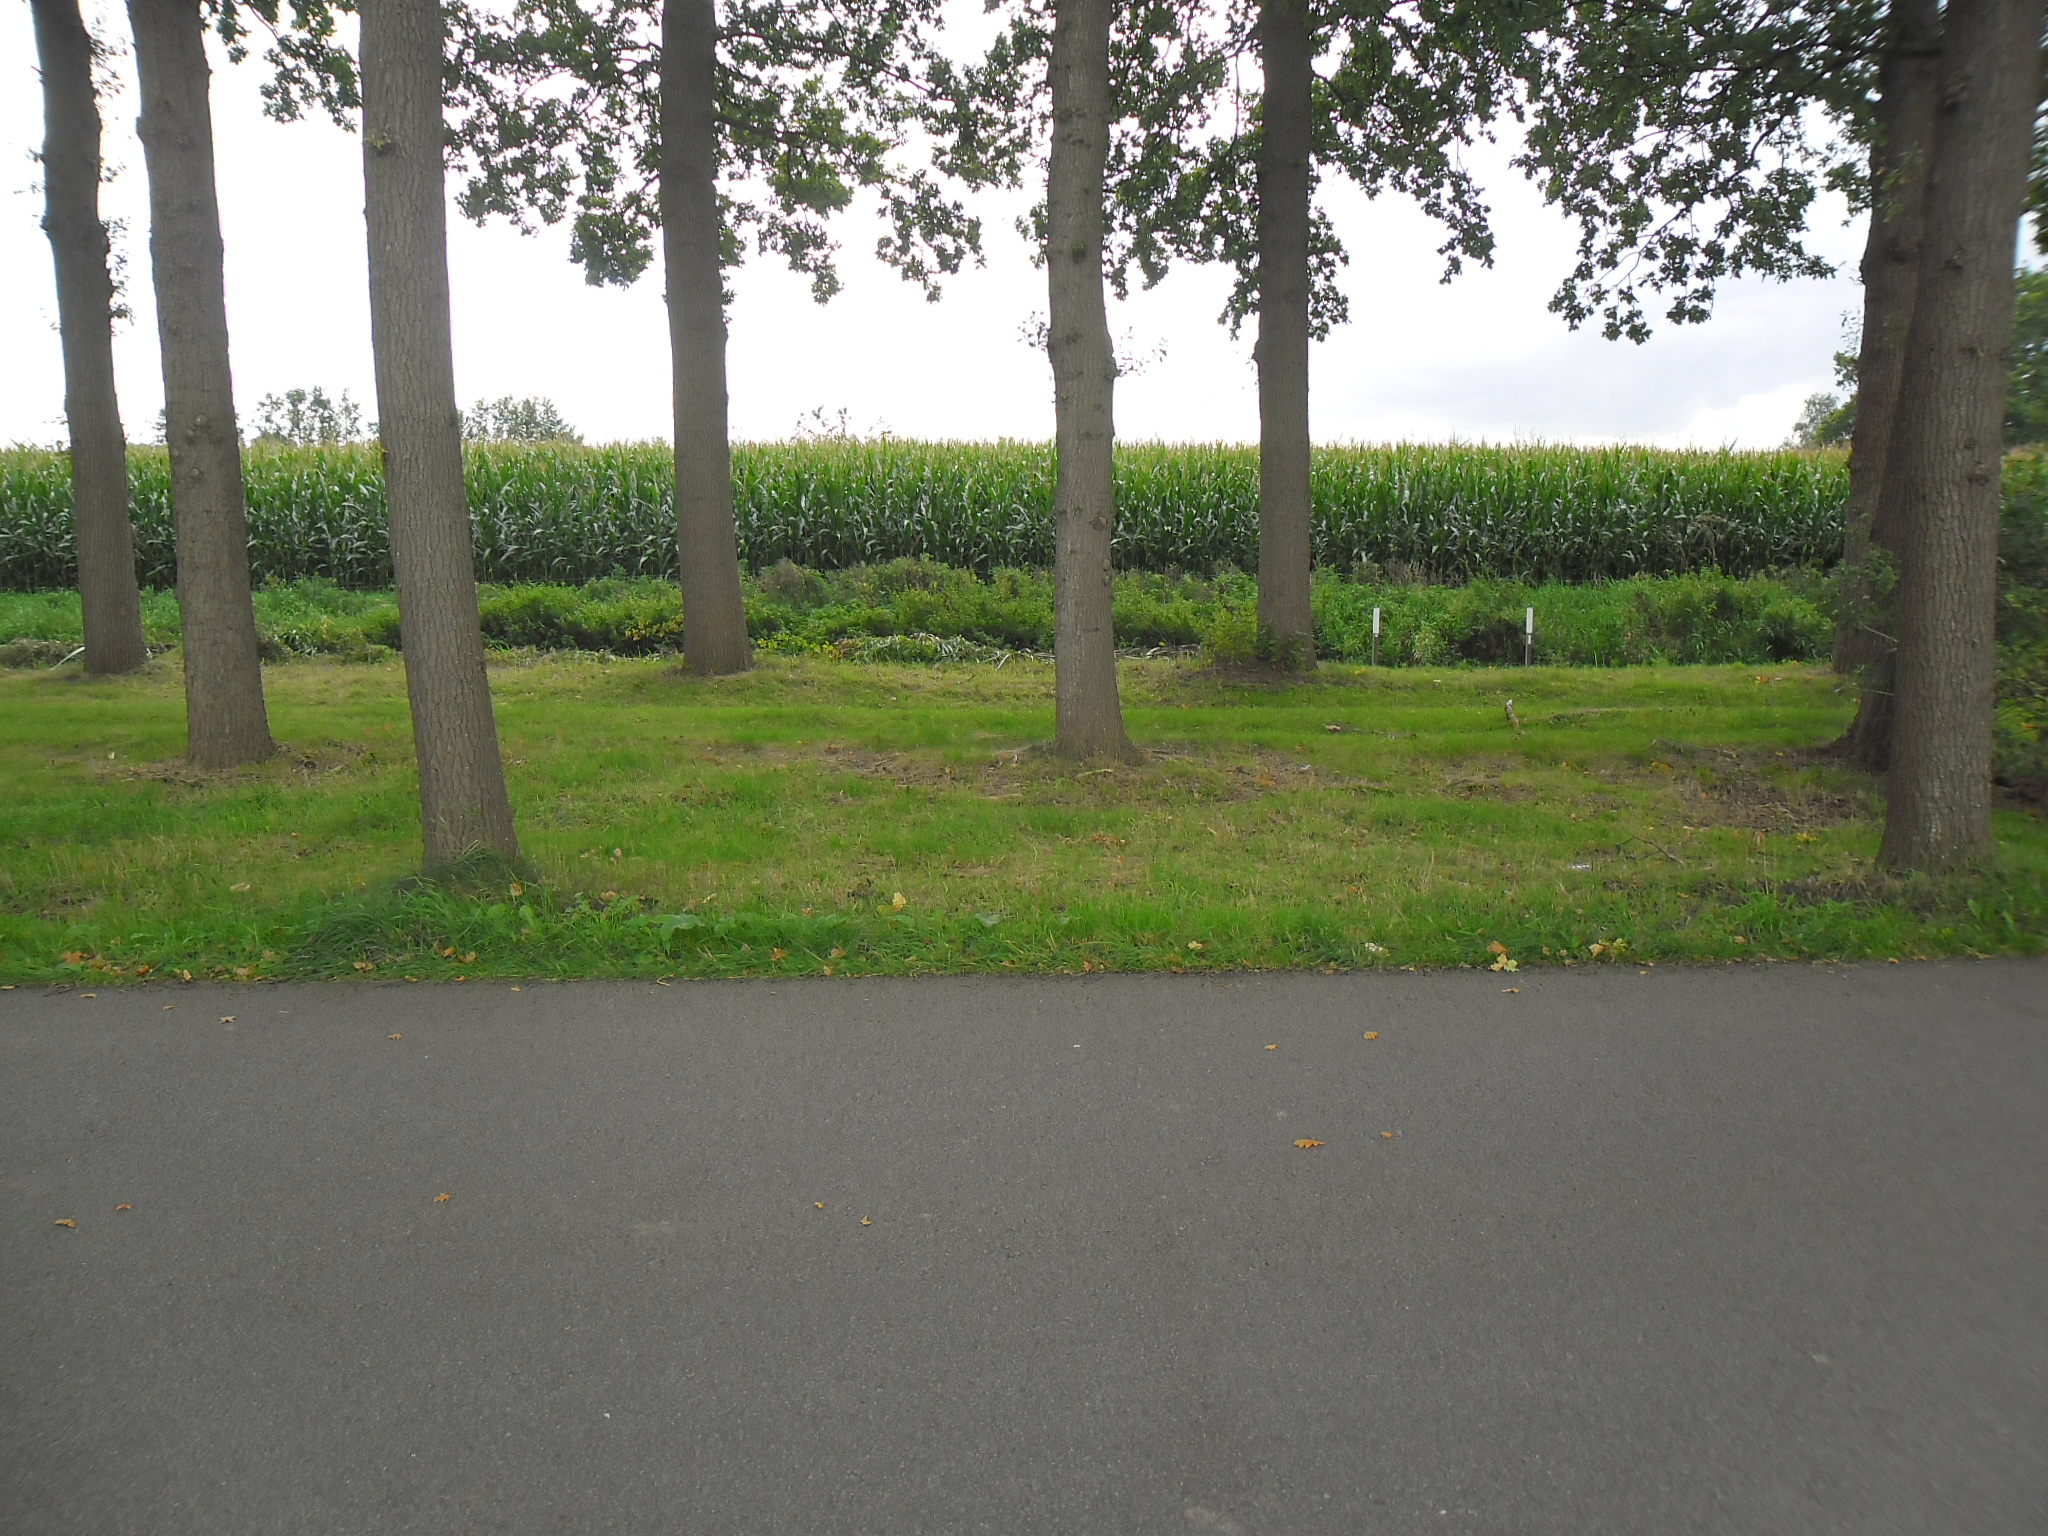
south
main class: Grassland
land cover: Grassland without tree/shrub cover
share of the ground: > 75 %
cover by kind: herbaceous plants 100 %
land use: Agriculture (excluding fallow land and kitchen gardens)
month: September
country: NL
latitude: 52.1643
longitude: 5.4516
